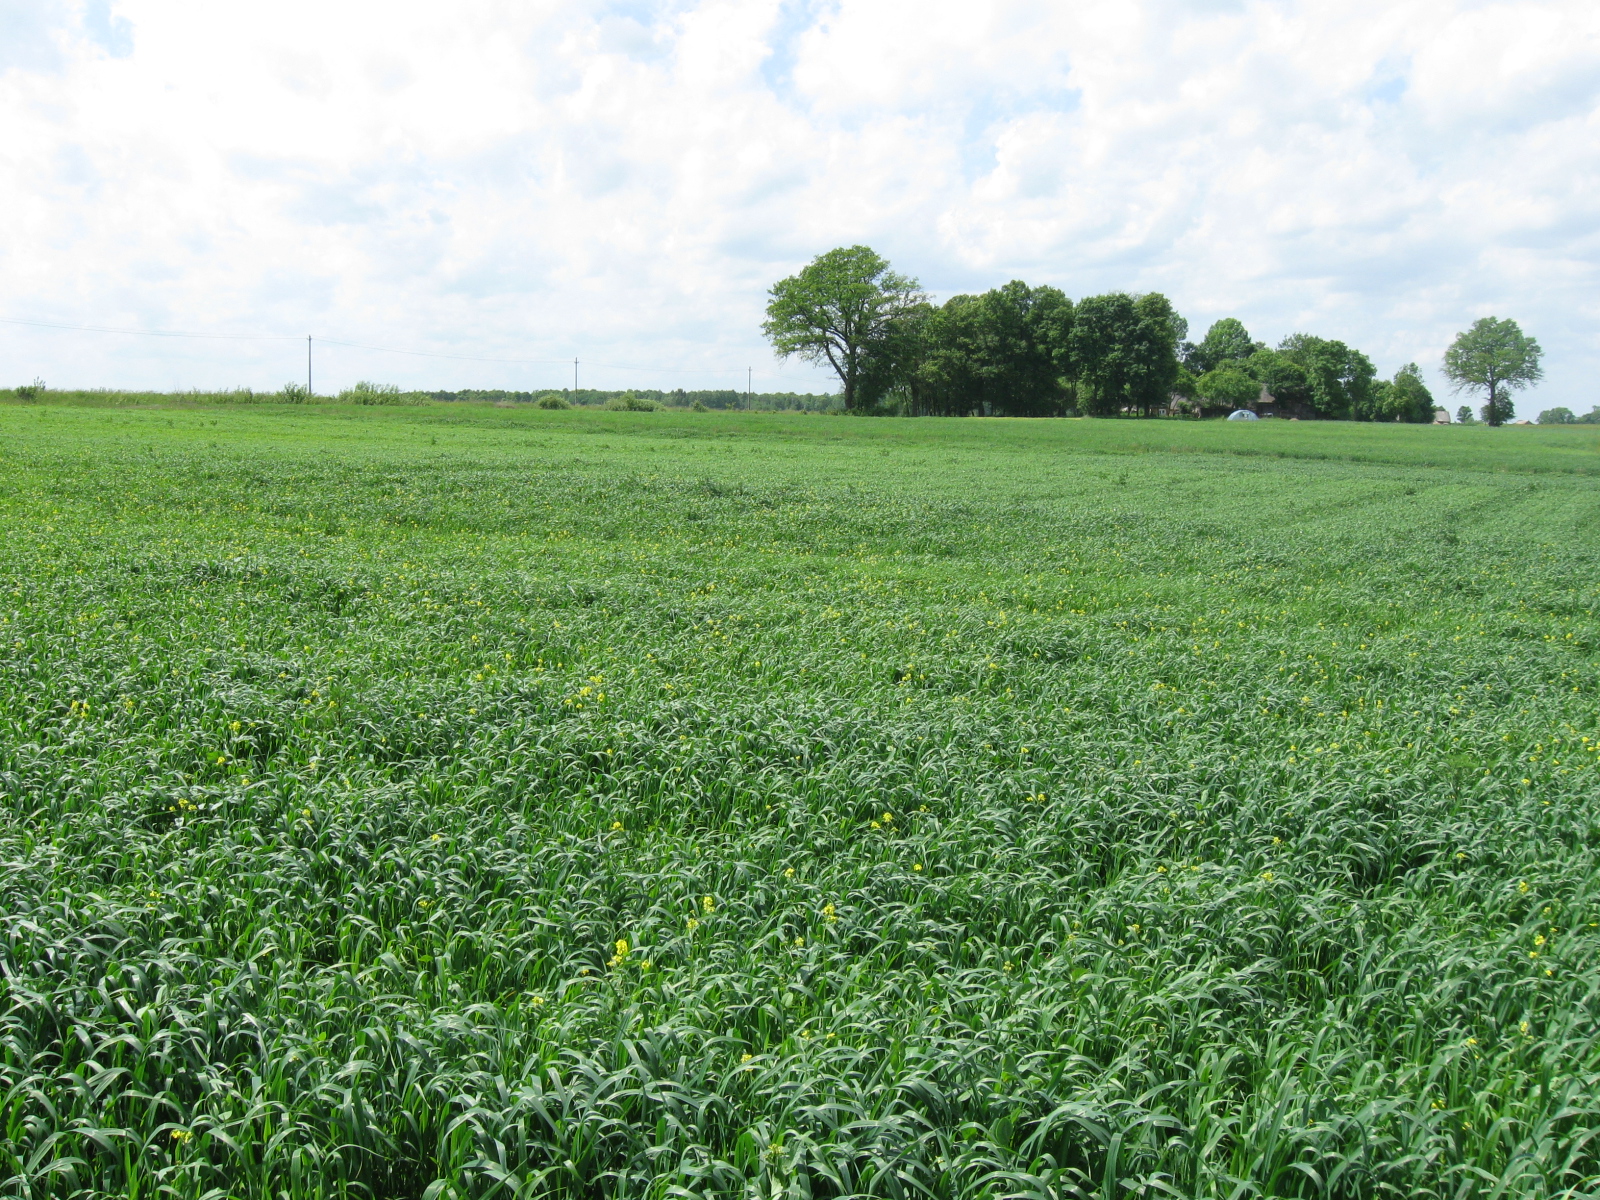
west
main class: Cropland
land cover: Oats
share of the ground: > 75 %
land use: Agriculture (excluding fallow land and kitchen gardens)
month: June
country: LT
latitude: 54.3595
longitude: 23.7995
